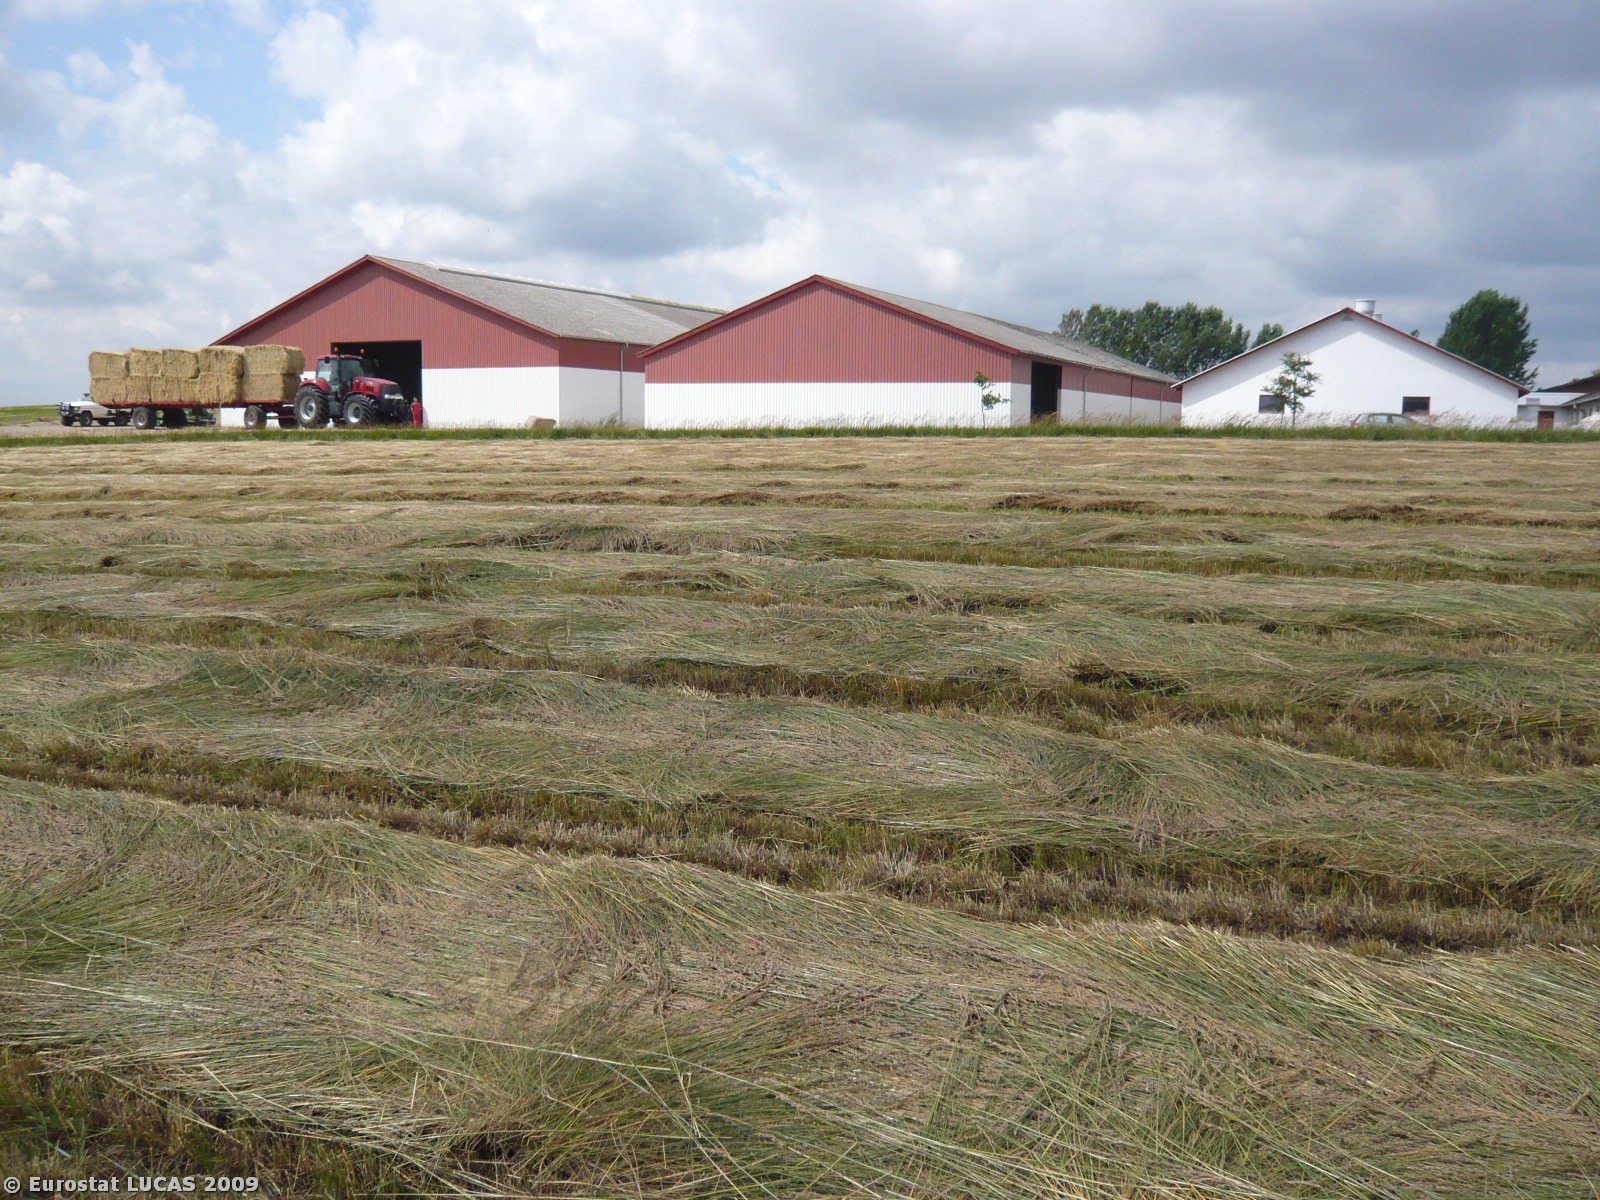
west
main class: Cropland
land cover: Temporary grasslands
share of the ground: > 75 %
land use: Agriculture (excluding fallow land and kitchen gardens)
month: July
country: DK
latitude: 55.4888
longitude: 12.0083
